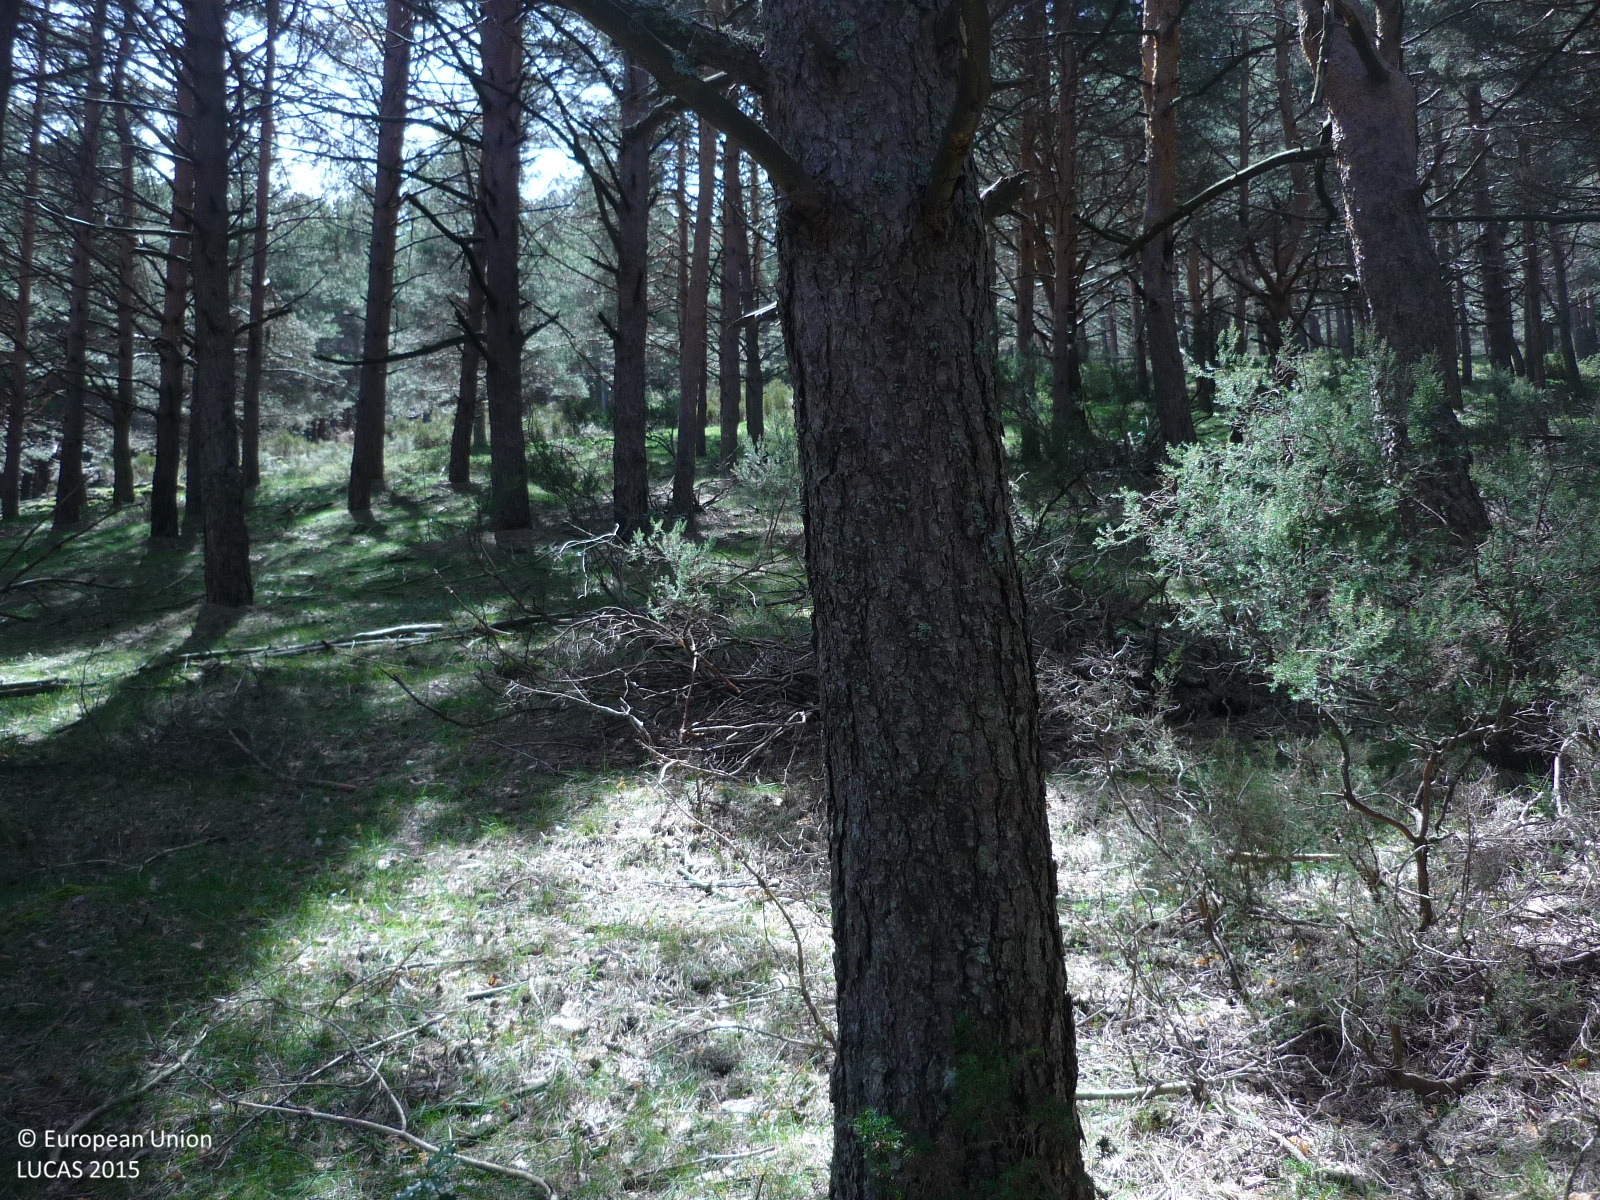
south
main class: Woodland
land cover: Pine dominated coniferous woodland
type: coniferous forest of the mediterranean region
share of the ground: > 75 %
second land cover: Grassland without tree/shrub cover
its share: > 75 %
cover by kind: coniferous forest trees 90 %, herbaceous plants 10 %
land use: Forestry
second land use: Agriculture (excluding fallow land and kitchen gardens)
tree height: > 5 m
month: April
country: ES
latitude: 41.1265
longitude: -3.6122
